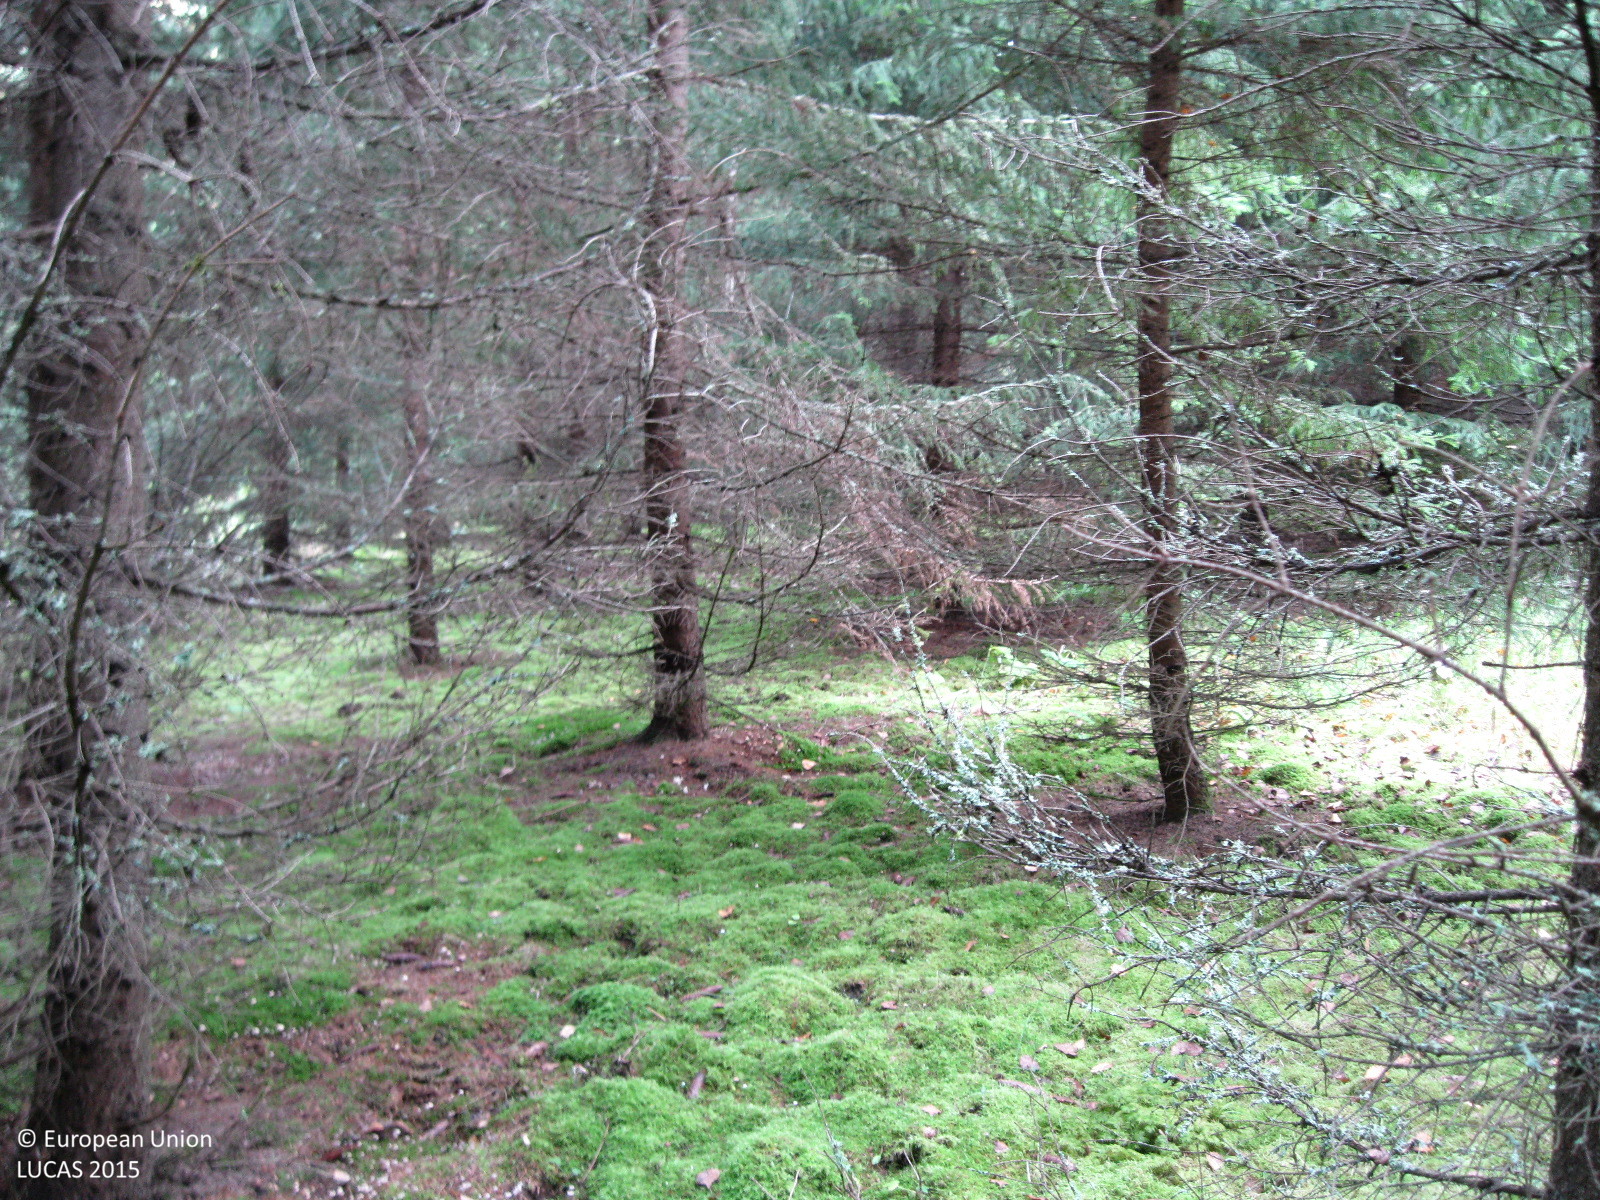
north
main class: Woodland
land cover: Spruce dominated coniferous woodland
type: boreal forest
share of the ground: > 75 %
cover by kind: coniferous forest trees 85 %, lichens and mosses 10 %, herbaceous plants 5 %
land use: Forestry
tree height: > 5 m
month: September
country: FI
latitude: 60.3888
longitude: 24.2353
